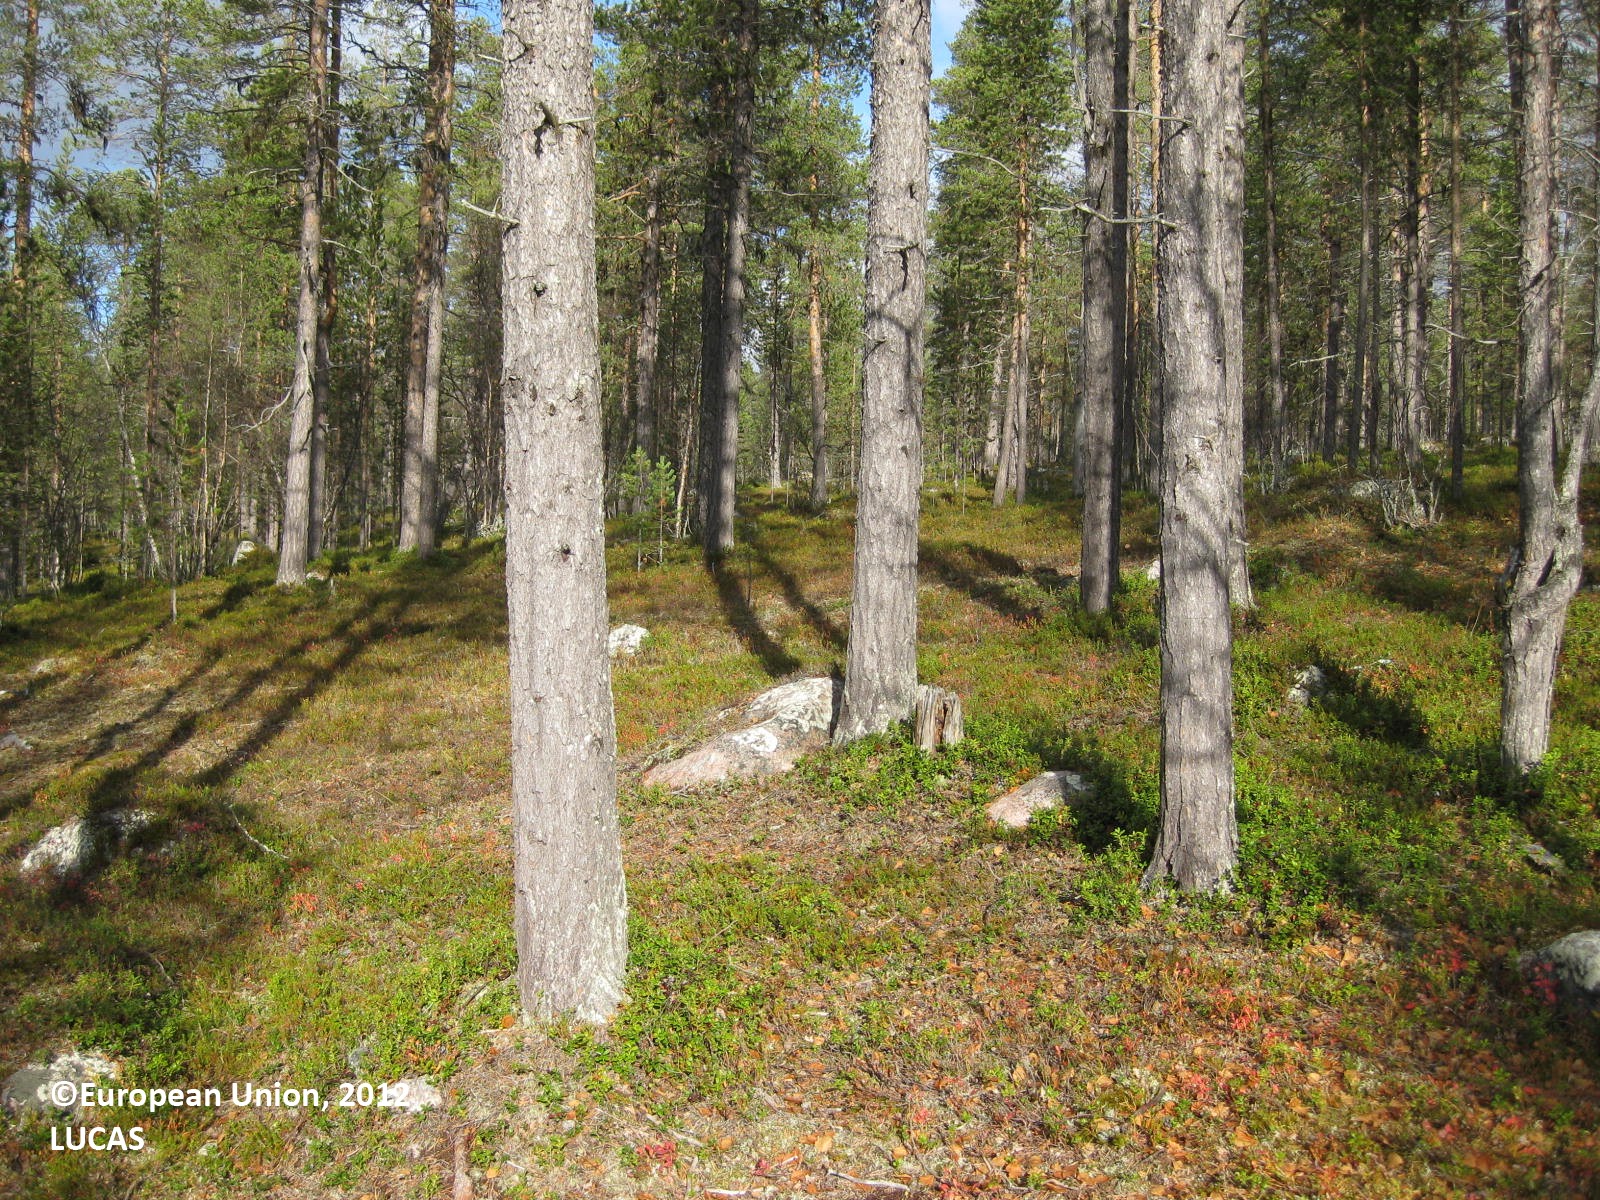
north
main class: Woodland
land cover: Pine dominated coniferous woodland
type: boreal forest
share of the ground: 50 - 75 %
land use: Forestry
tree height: > 5 m
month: September
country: FI
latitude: 68.0544
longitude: 23.7505
